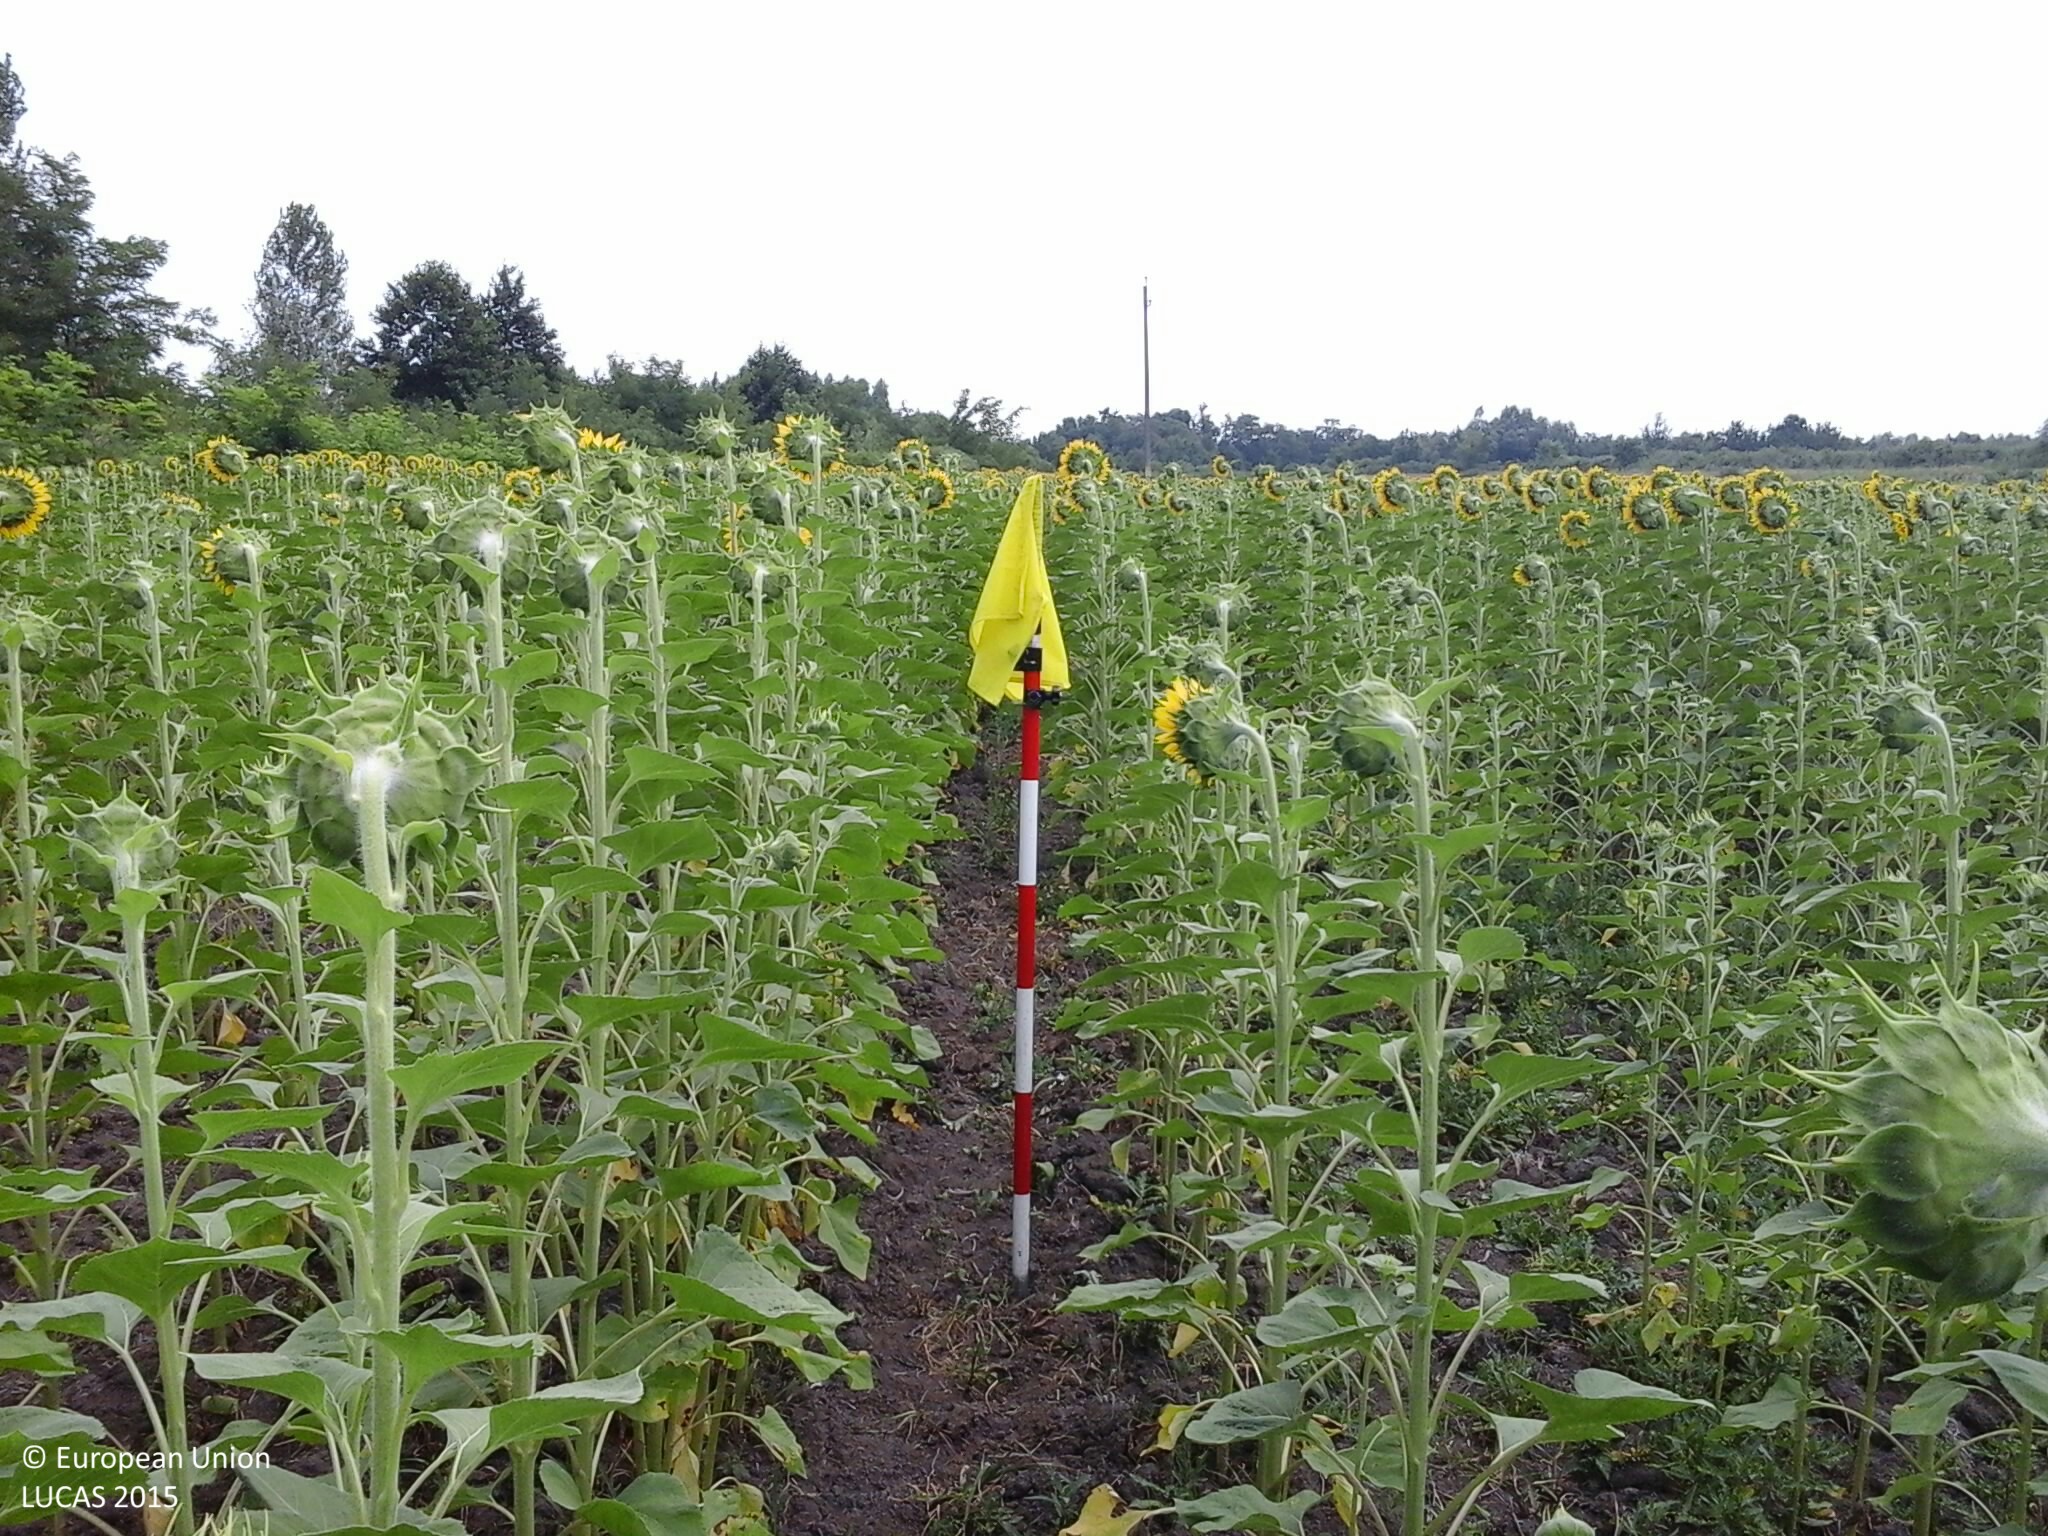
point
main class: Cropland
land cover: Sunflower
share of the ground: > 75 %
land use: Agriculture (excluding fallow land and kitchen gardens)
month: July
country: HU
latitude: 47.7754
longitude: 21.0480
